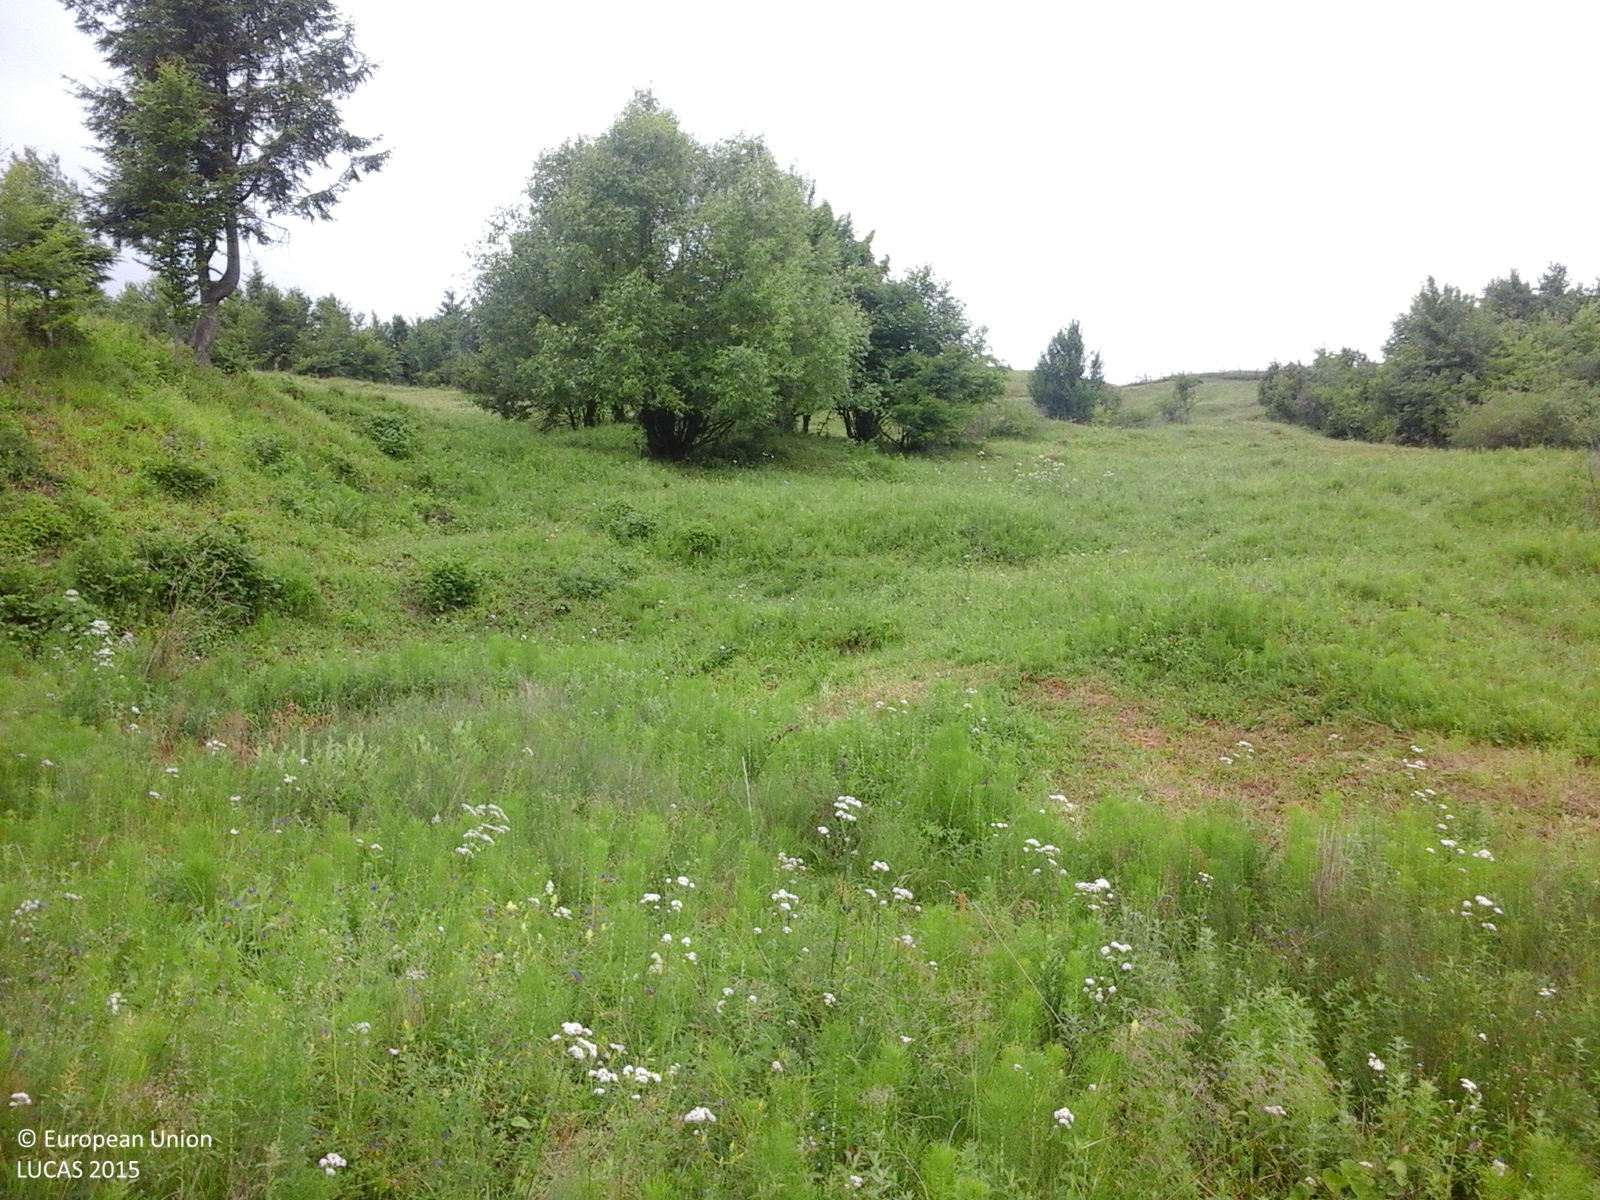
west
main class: Grassland
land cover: Spontaneously vegetated surfaces
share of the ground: > 75 %
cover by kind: herbaceous plants 100 %
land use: Agriculture (excluding fallow land and kitchen gardens)
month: June
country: RO
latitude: 47.3389
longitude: 26.2406
